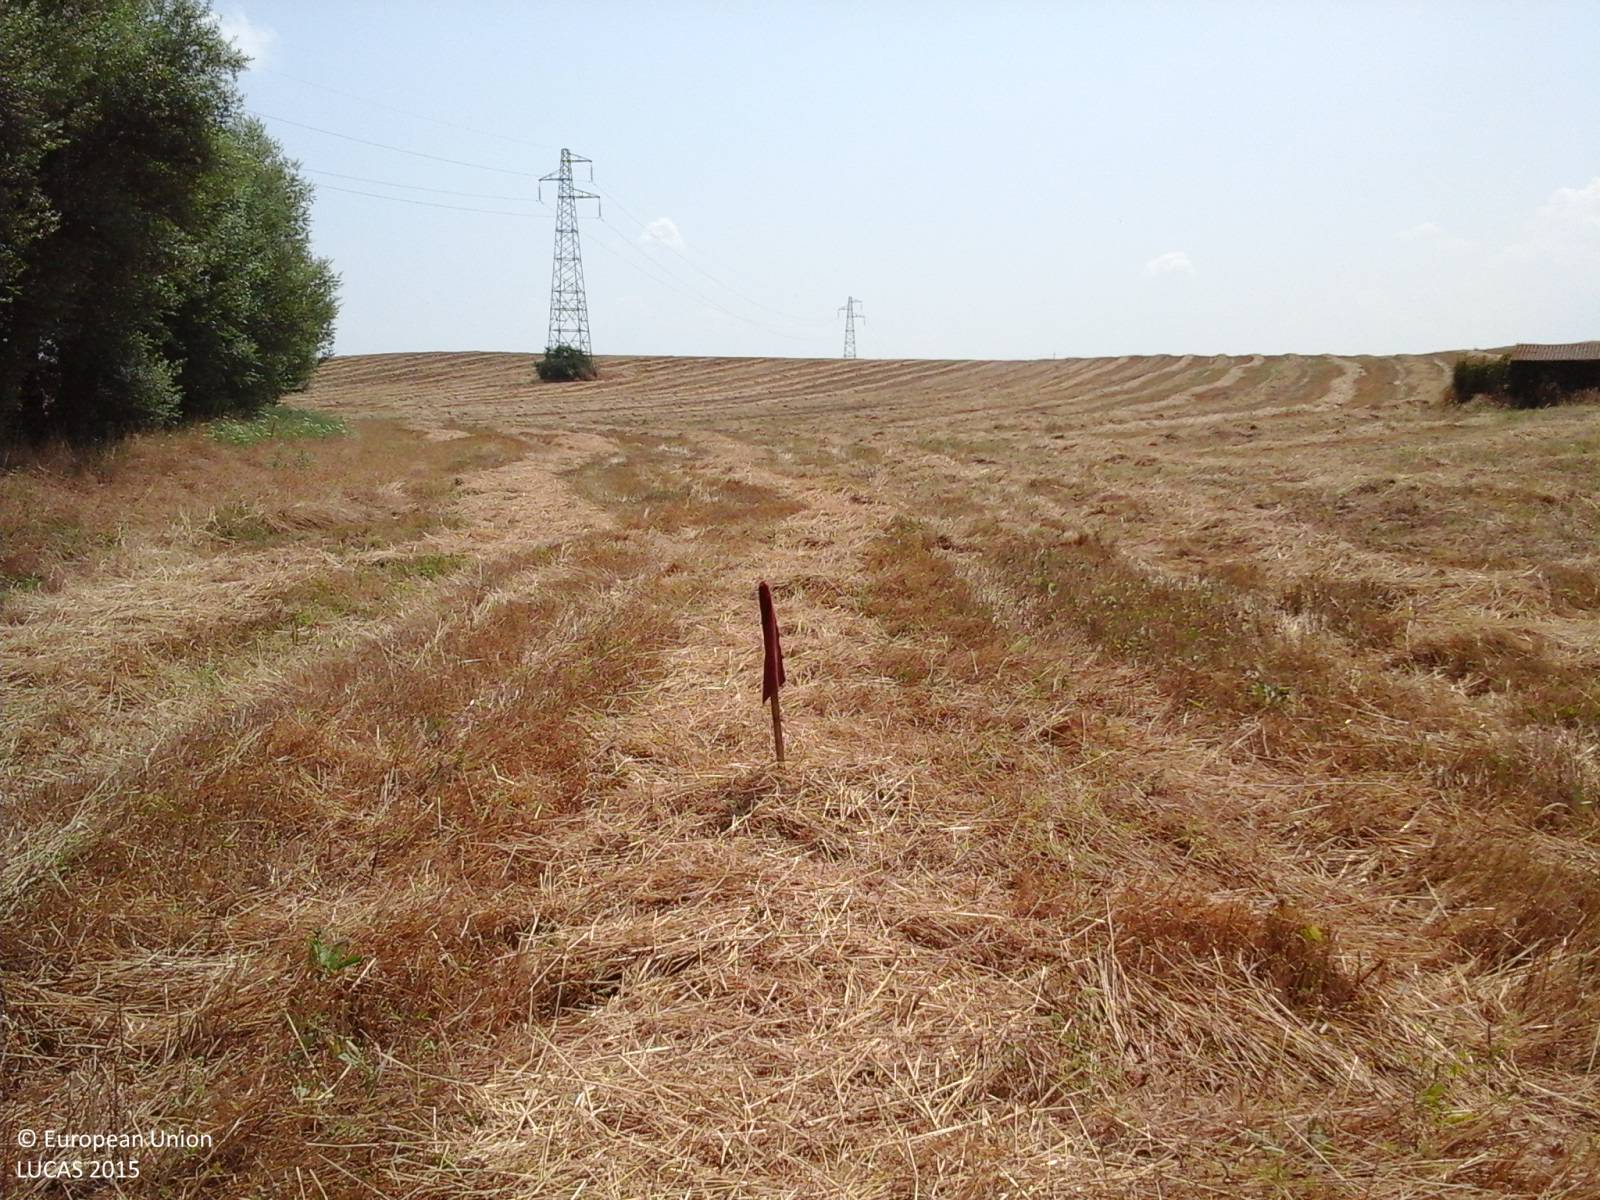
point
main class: Cropland
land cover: Temporary grasslands
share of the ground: > 75 %
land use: Agriculture (excluding fallow land and kitchen gardens)
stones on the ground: < 10 %
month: July
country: IT
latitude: 41.9710
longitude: 12.5609
